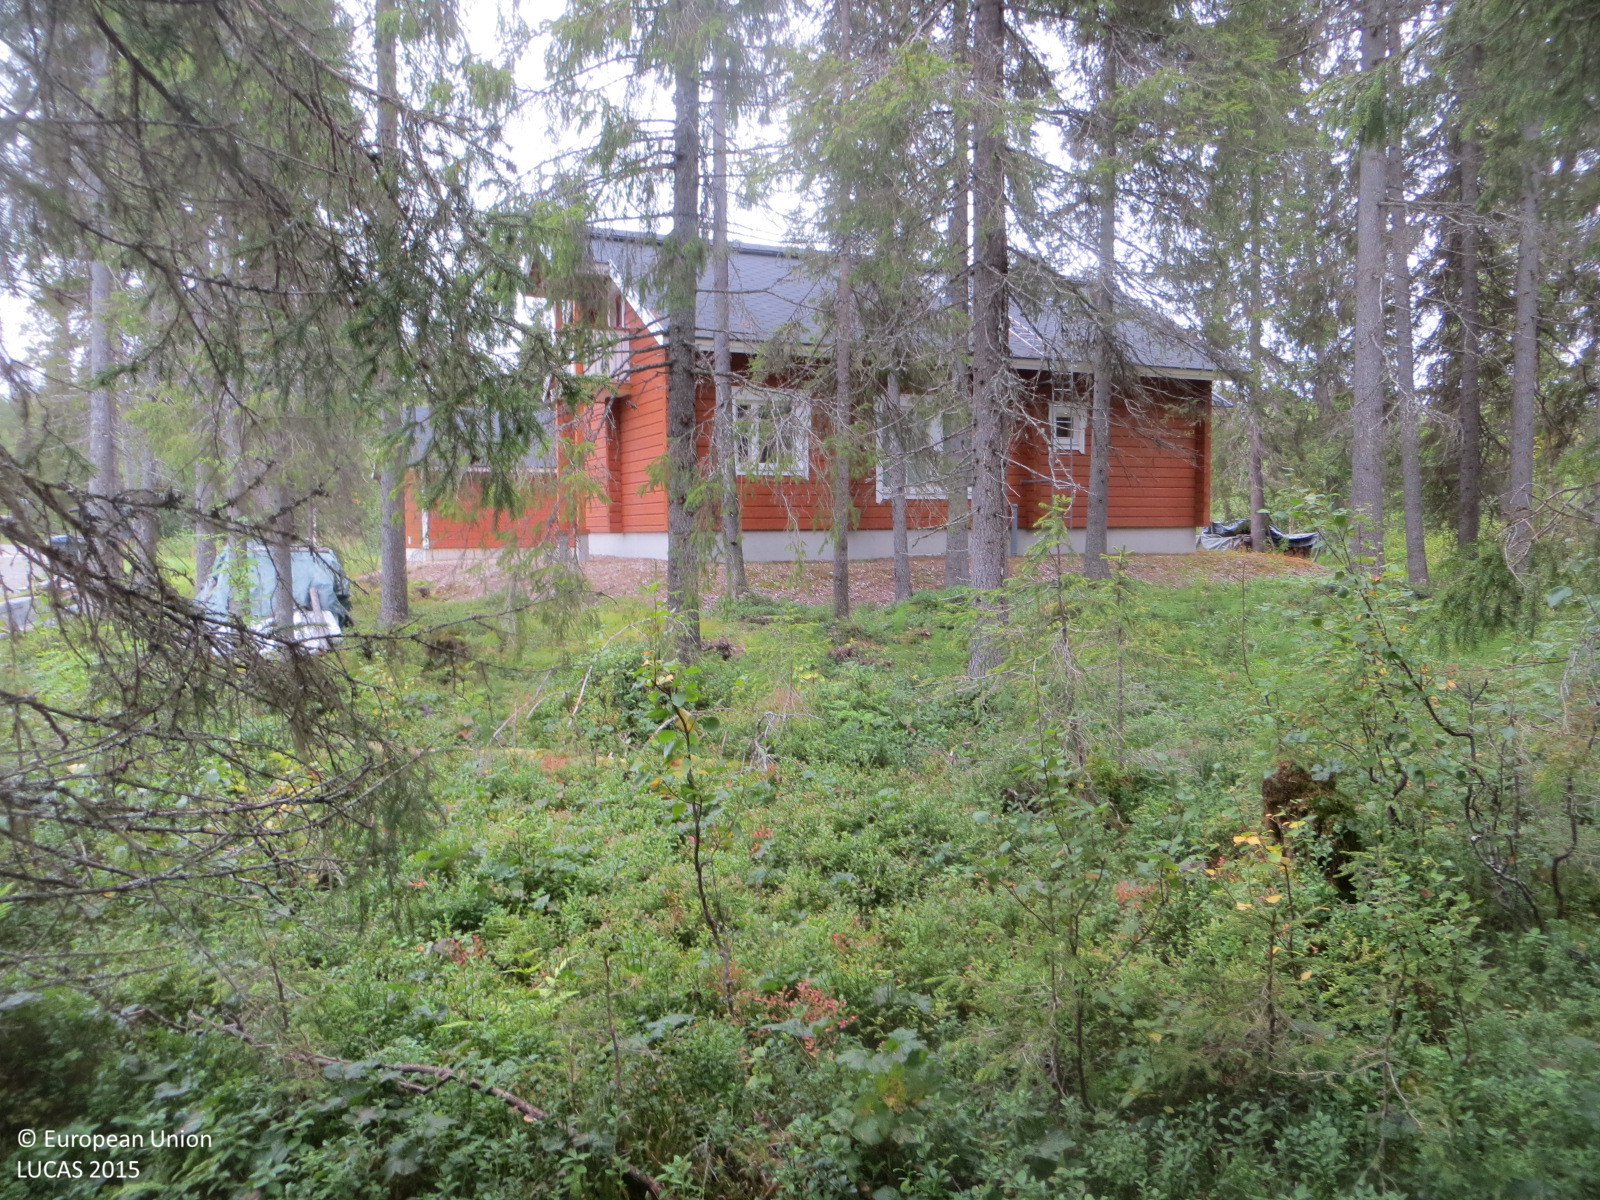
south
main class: Woodland
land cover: Spruce dominated coniferous woodland
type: boreal forest
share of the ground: > 75 %
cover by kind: coniferous forest trees 75 %, shrubs 25 %
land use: Forestry
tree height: > 5 m
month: August
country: FI
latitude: 67.5331
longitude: 24.2600
